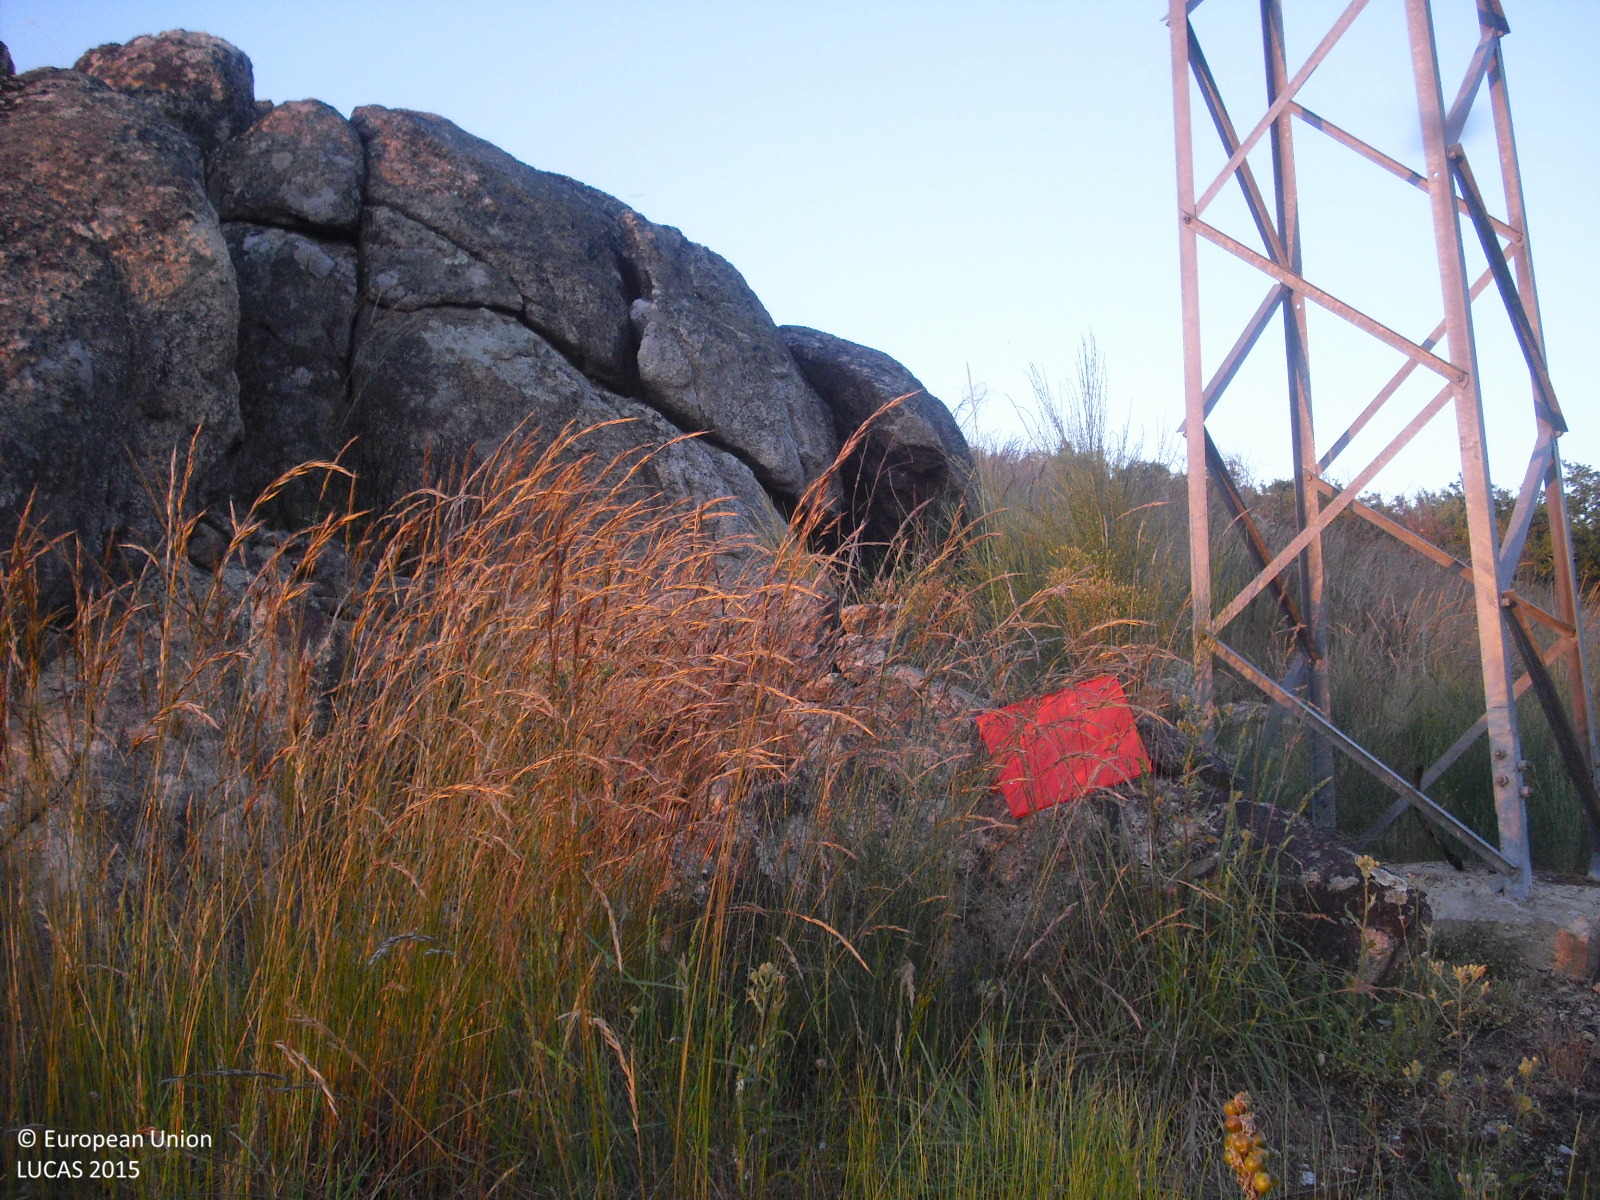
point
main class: Artificial land
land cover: Other artificial areas
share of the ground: < 10 %
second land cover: Shrubland with sparse tree cover
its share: 25 - 50 %
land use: Electricity, gas and thermal power distribution
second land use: Agriculture (excluding fallow land and kitchen gardens)
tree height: < 5 m
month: May
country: ES
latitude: 42.2025
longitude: -7.7172
